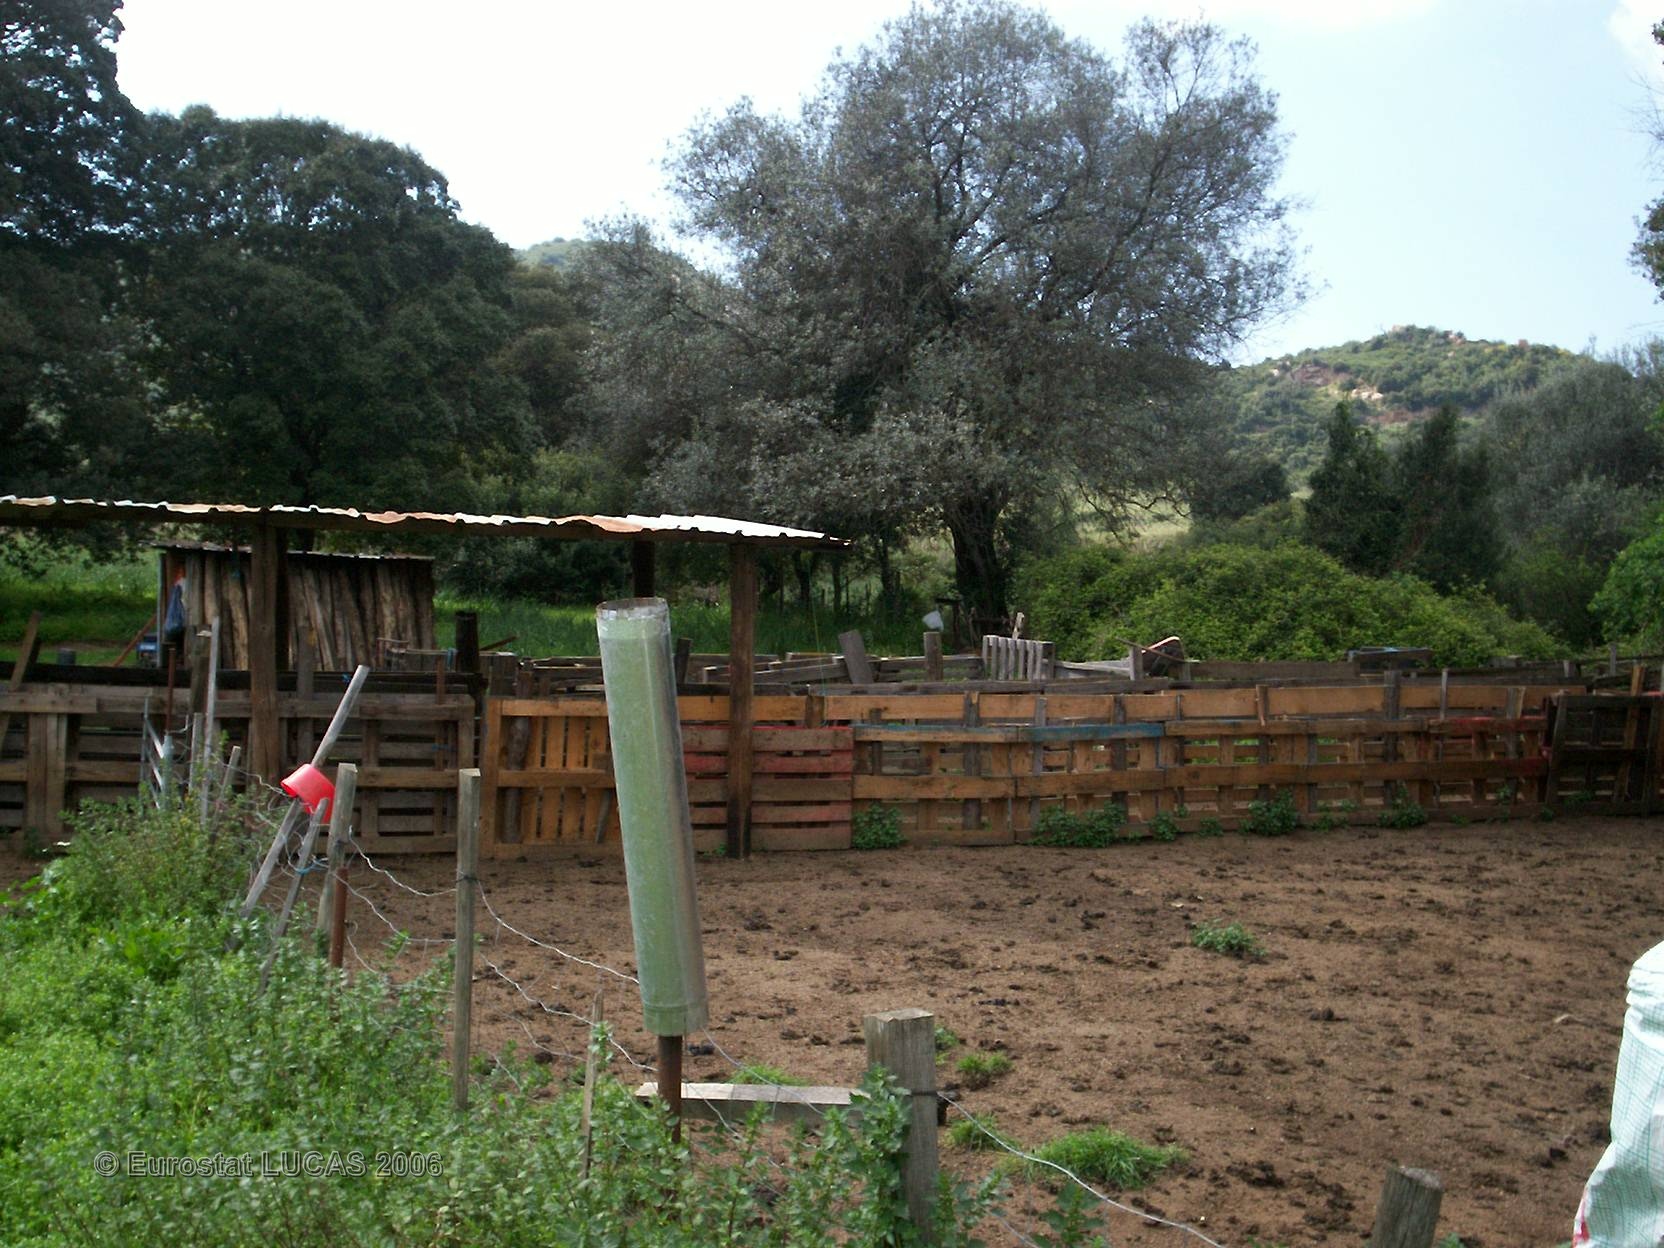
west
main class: Grassland
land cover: Grassland without tree/shrub cover
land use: Agriculture (excluding fallow land and kitchen gardens)
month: April
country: FR
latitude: 41.9960
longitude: 8.7613
